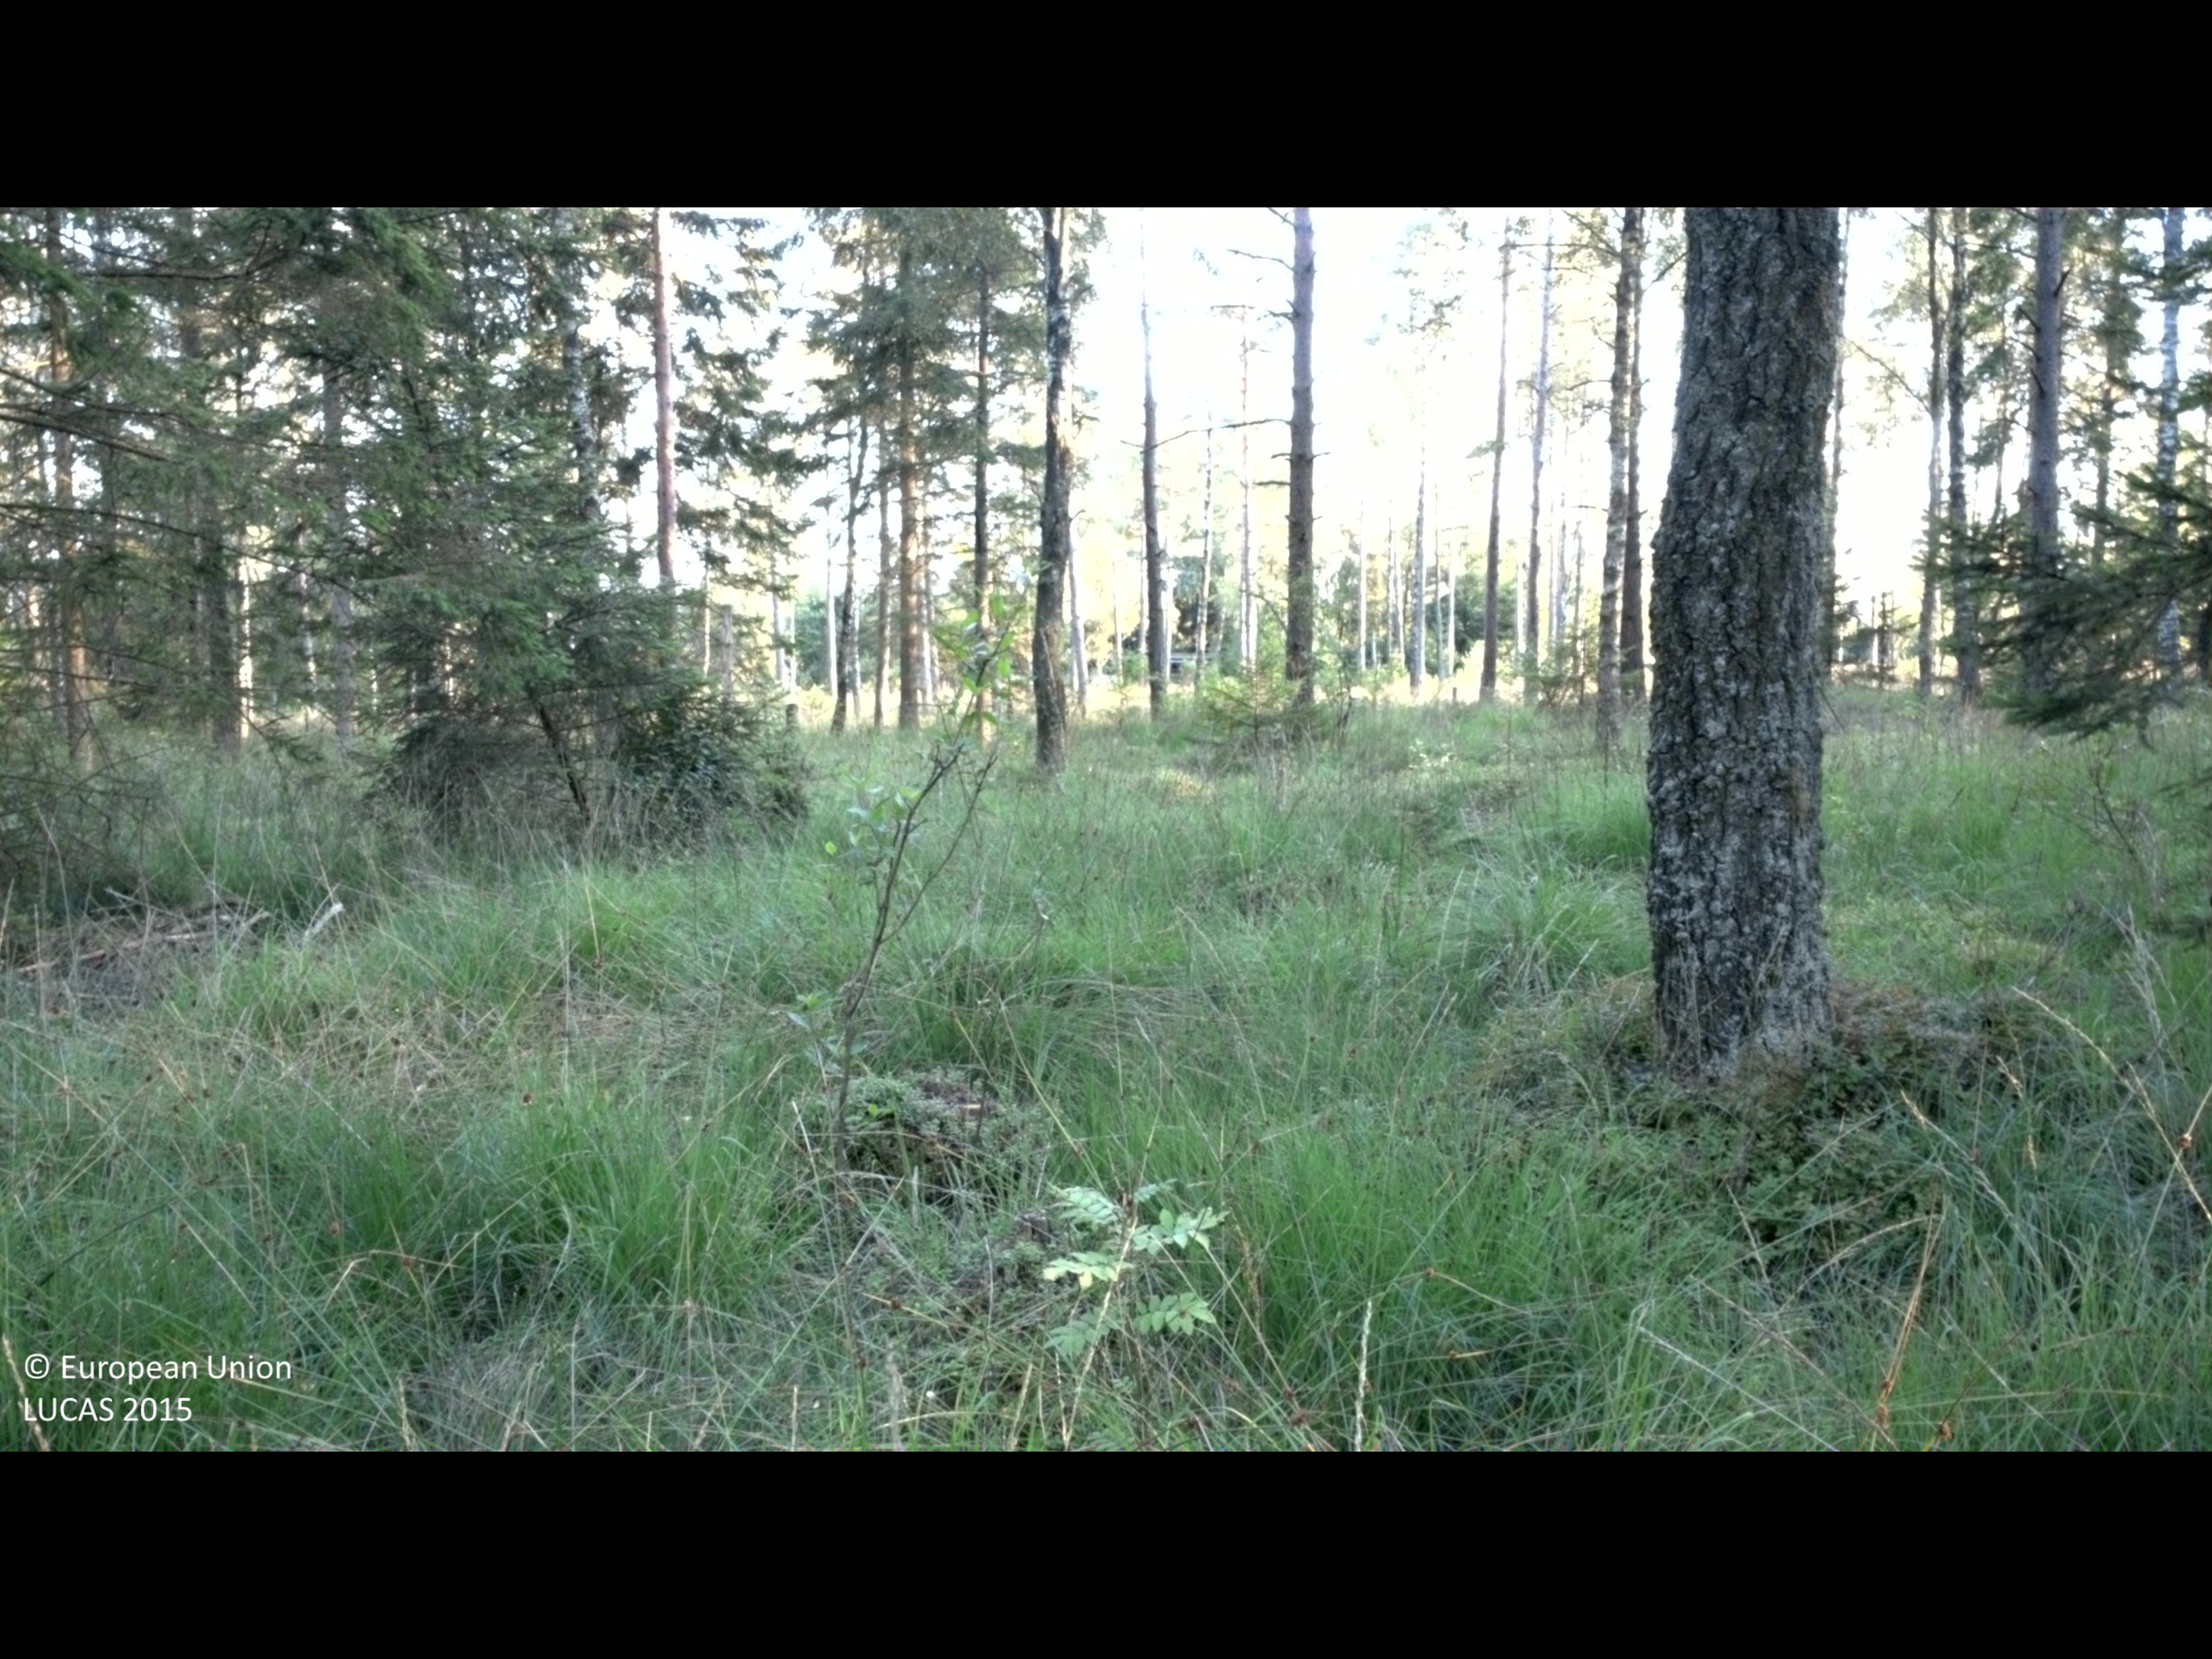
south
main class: Woodland
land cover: Pine dominated mixed woodland
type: boreal forest
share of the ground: 50 - 75 %
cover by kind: coniferous forest trees 45 %, herbaceous plants 30 %, broadleaved forest trees 15 %, shrubs 10 %
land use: Forestry
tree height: > 5 m
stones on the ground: < 10 %
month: August
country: SE
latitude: 56.7428
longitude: 13.1523
